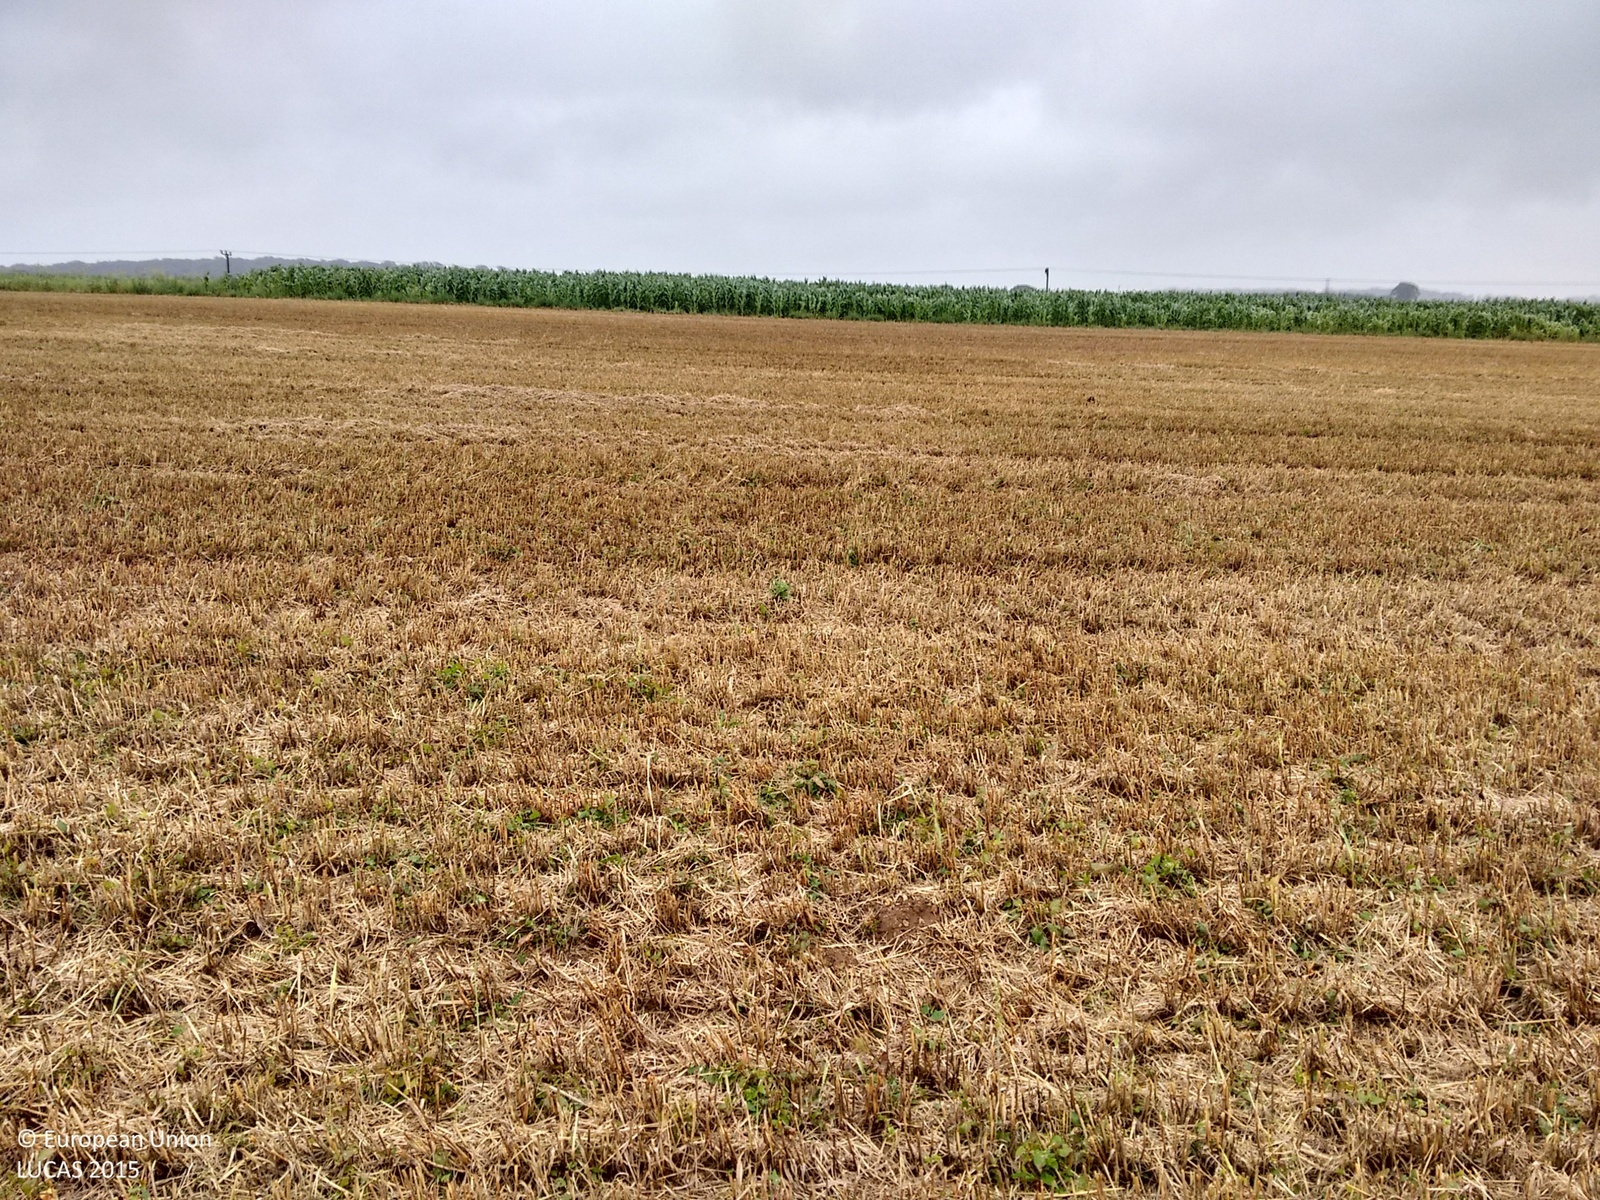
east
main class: Cropland
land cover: Common wheat
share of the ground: > 75 %
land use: Agriculture (excluding fallow land and kitchen gardens)
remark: Harvested field
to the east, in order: Common wheat; Maize; Spontaneously vegetated surfaces; Grass margins; Tracks; Grass margins; Managed hedges; Electric lines; Grass margins; Other bare soil
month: August
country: GB
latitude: 52.9220
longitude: 0.7684
